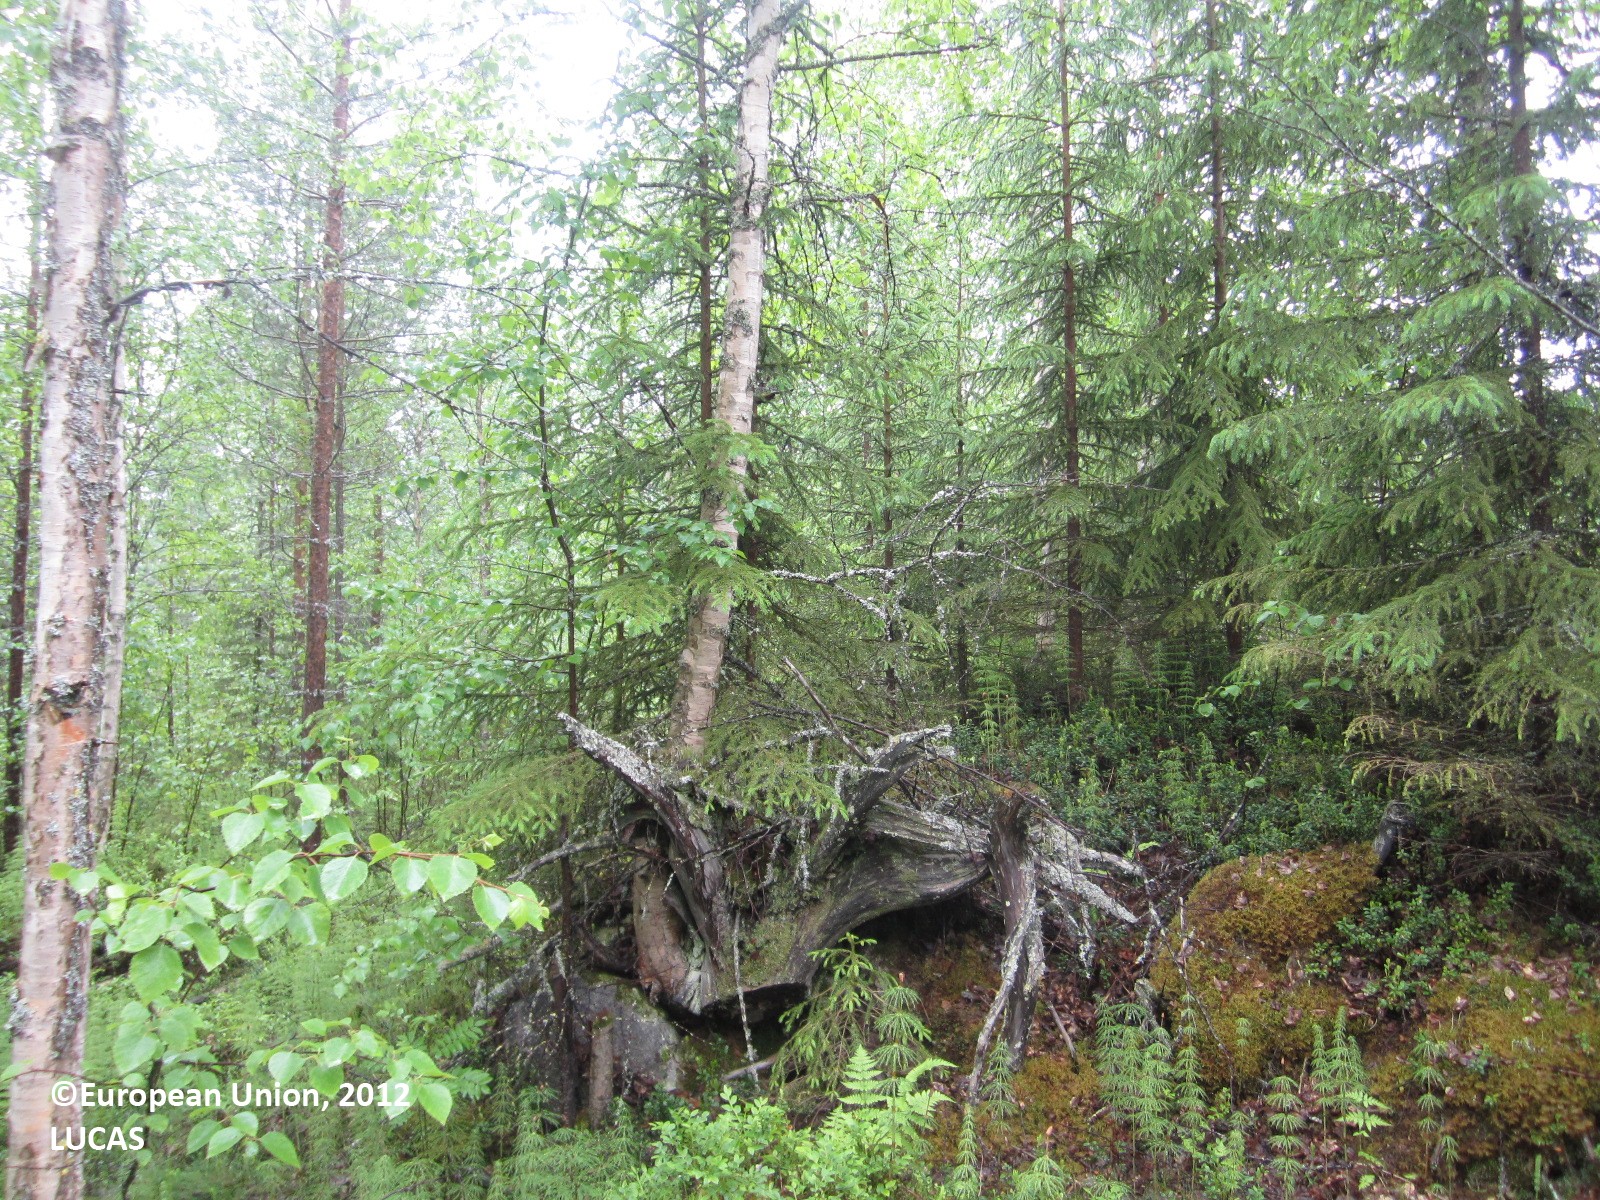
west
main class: Woodland
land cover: Spruce dominated mixed woodland
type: boreal forest
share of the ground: 50 - 75 %
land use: Forestry
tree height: > 5 m
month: June
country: FI
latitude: 64.3892
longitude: 29.4765
